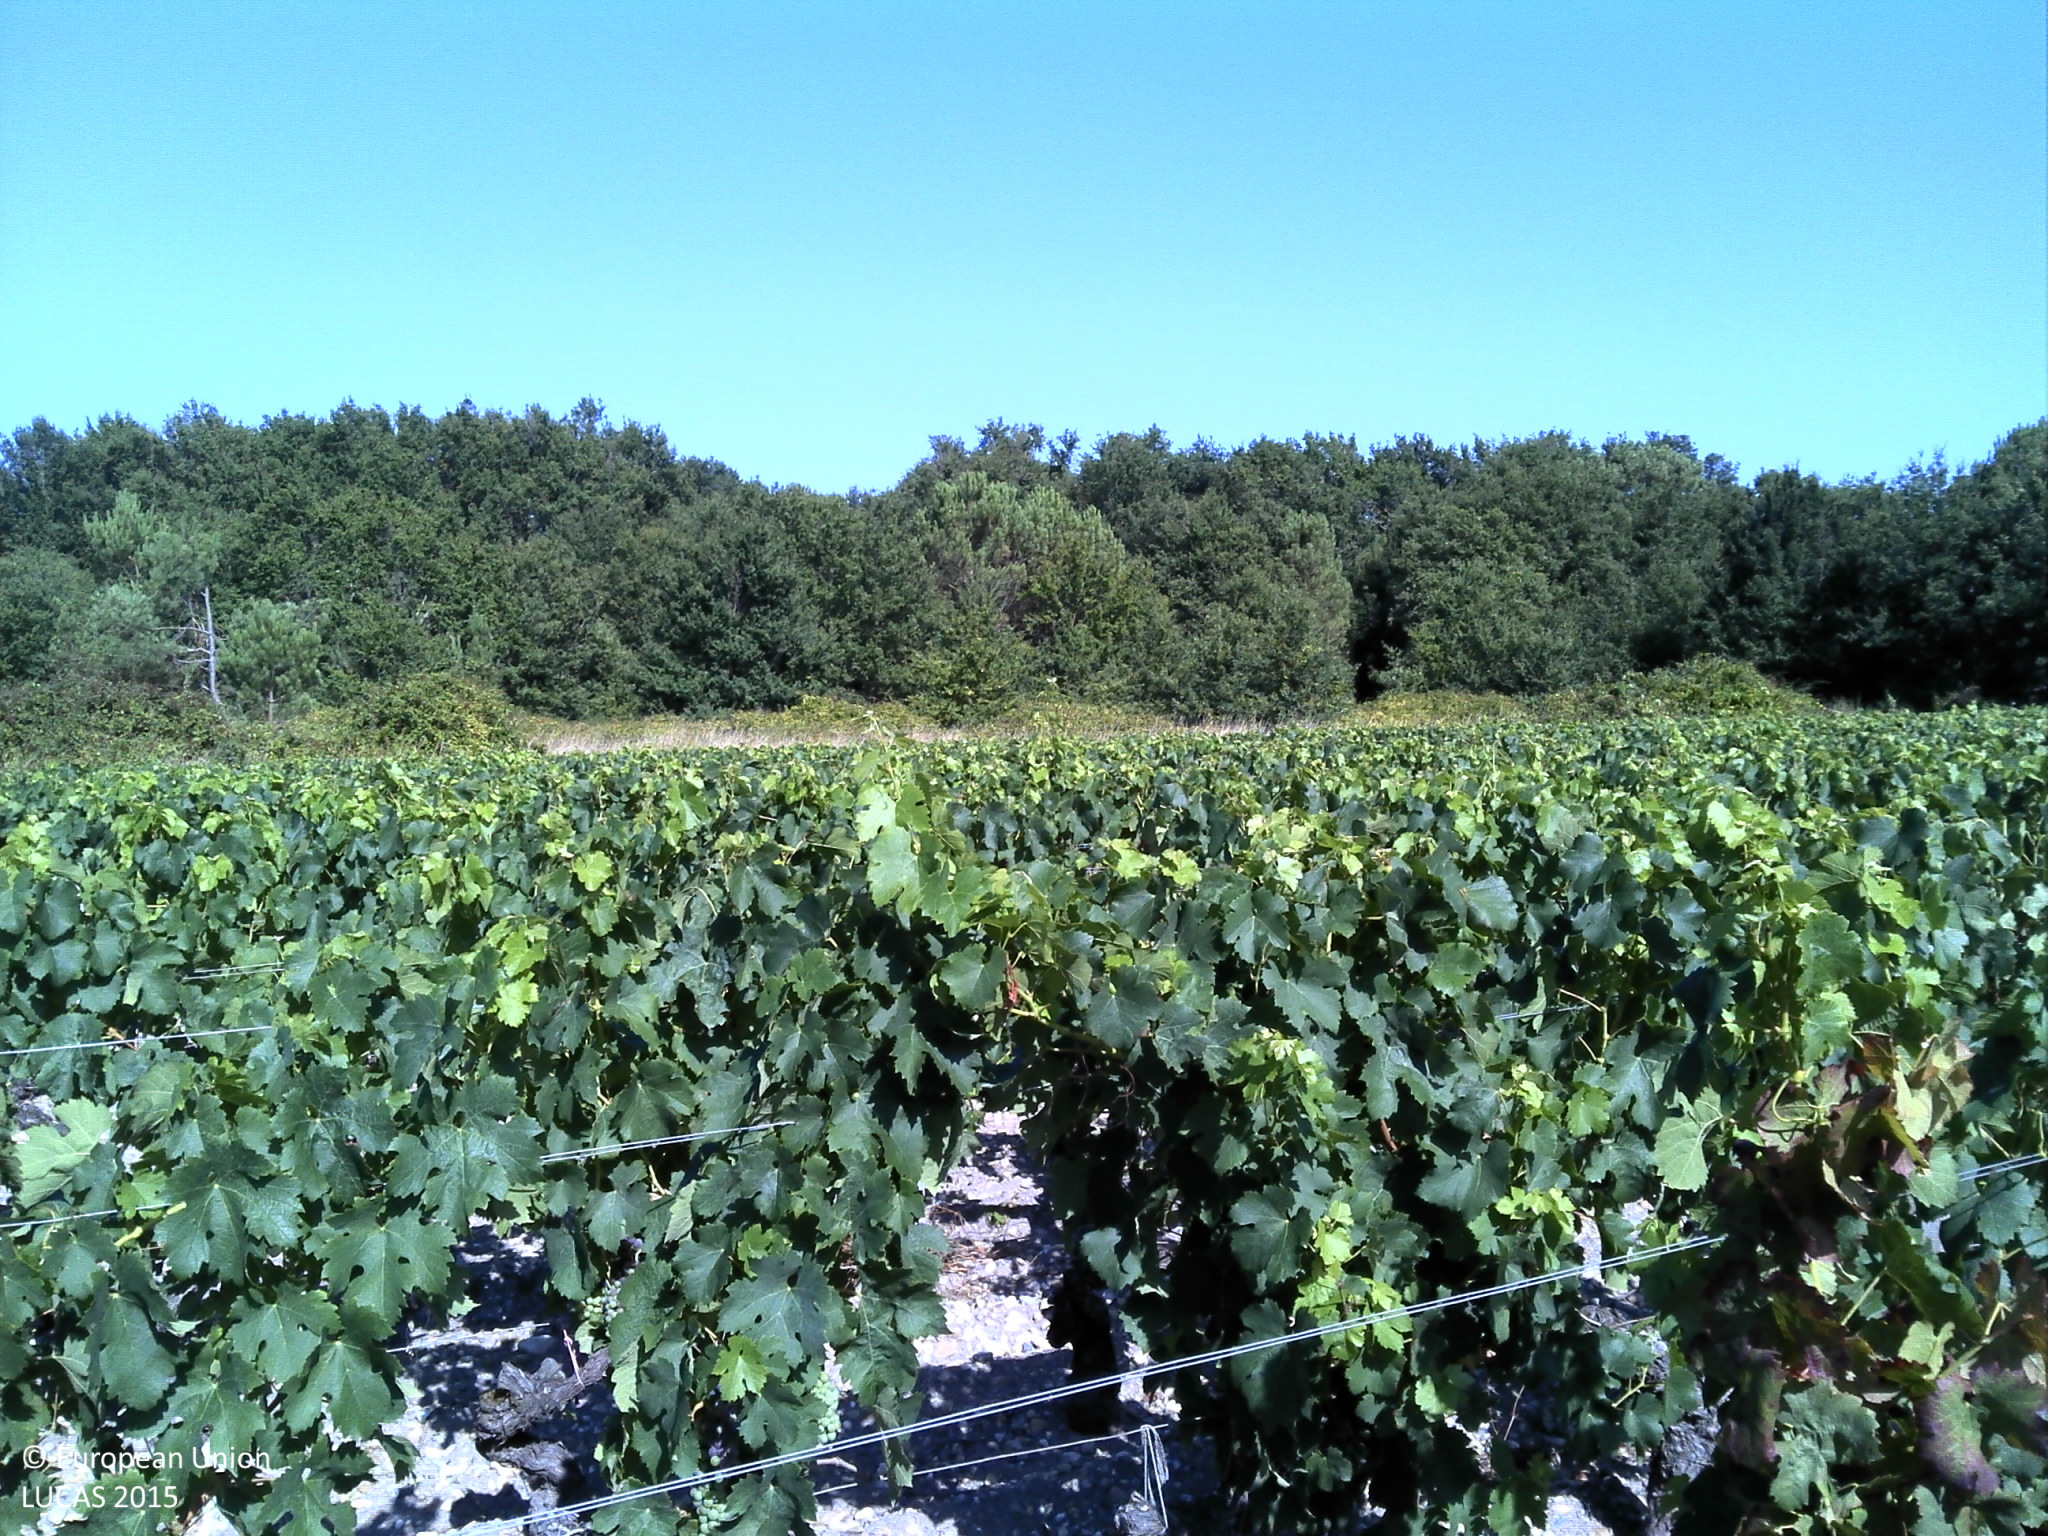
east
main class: Cropland
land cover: Vineyards
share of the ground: 25 - 50 %
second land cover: Other bare soil
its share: > 75 %
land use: Agriculture (excluding fallow land and kitchen gardens)
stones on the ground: 25 - 50 %
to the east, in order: Vineyards; Other bare soil; Grass margins; Tracks; Grassland without tree/shrub cover; Shrubland with sparse tree cover; Broadleaved woodland; Tracks; Fences; Broadleaved woodland; Fences; Artificial constructions in urban areas
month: August
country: FR
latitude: 45.0804
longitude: -0.7563
